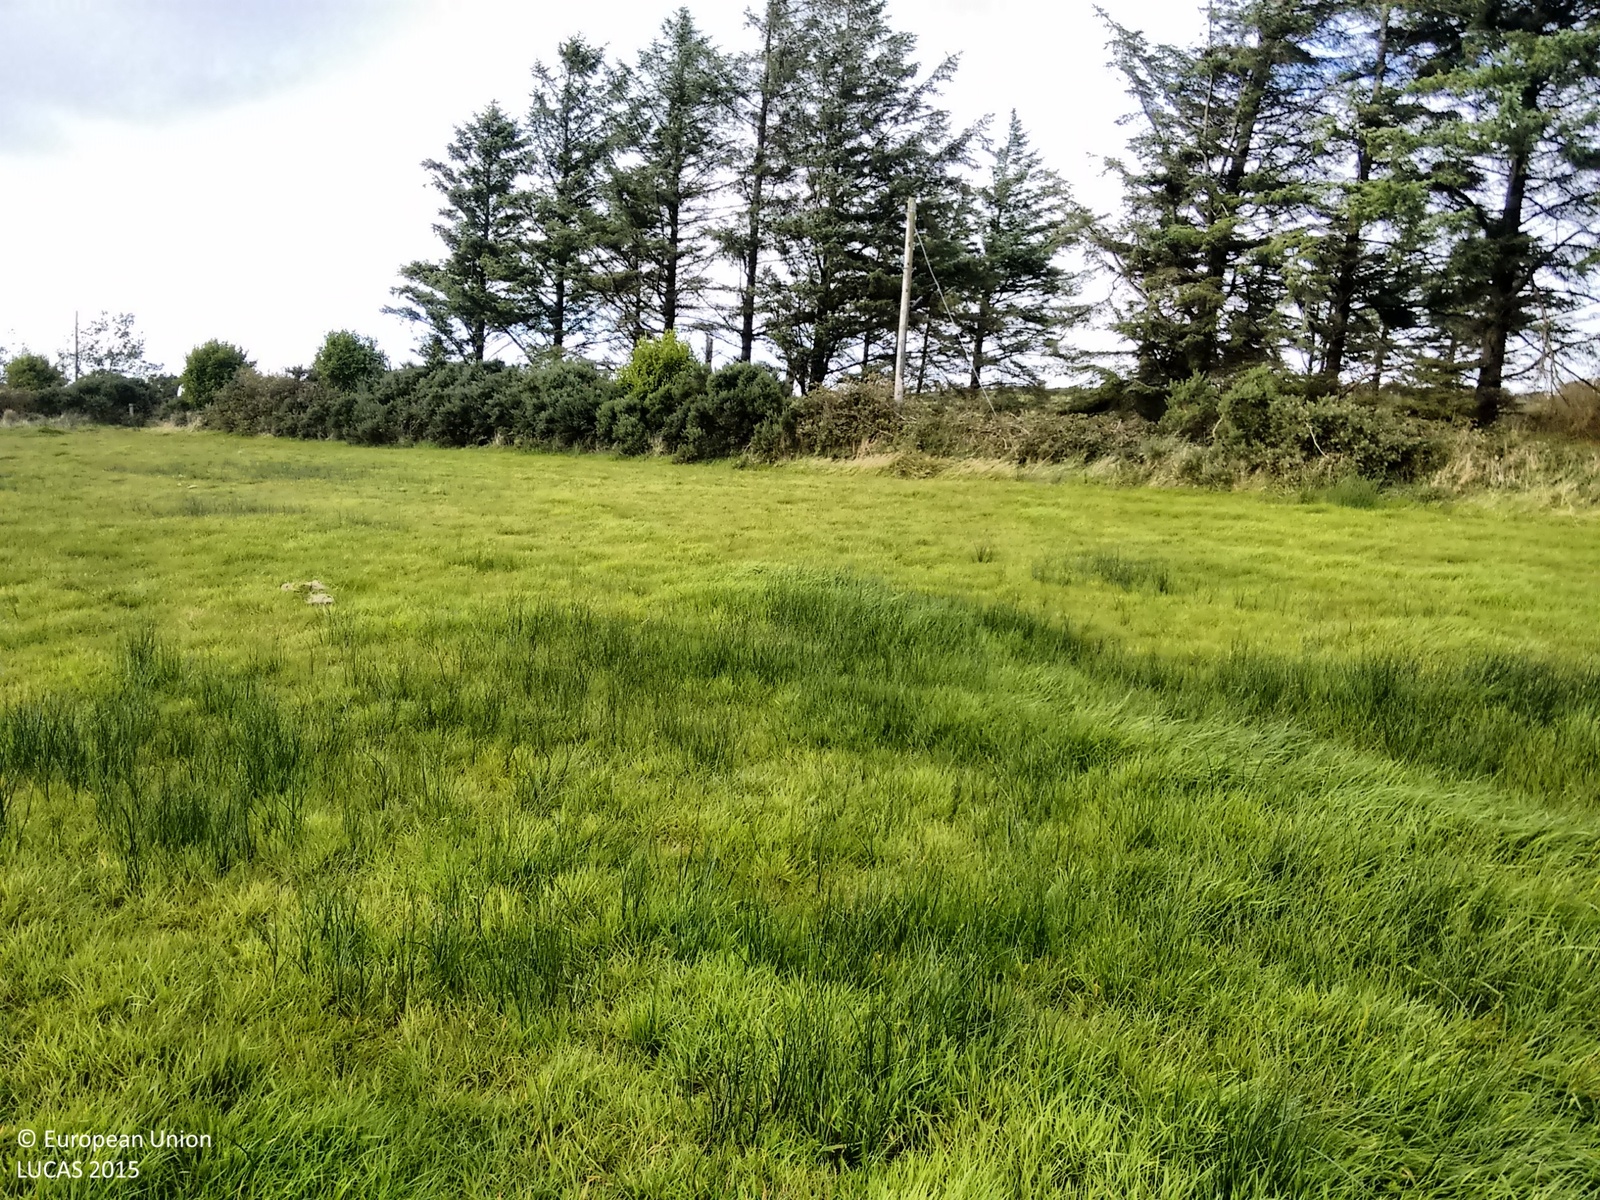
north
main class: Grassland
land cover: Grassland without tree/shrub cover
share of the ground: > 75 %
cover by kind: herbaceous plants 100 %
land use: Agriculture (excluding fallow land and kitchen gardens)
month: September
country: IE
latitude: 52.5280
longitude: -9.3140
